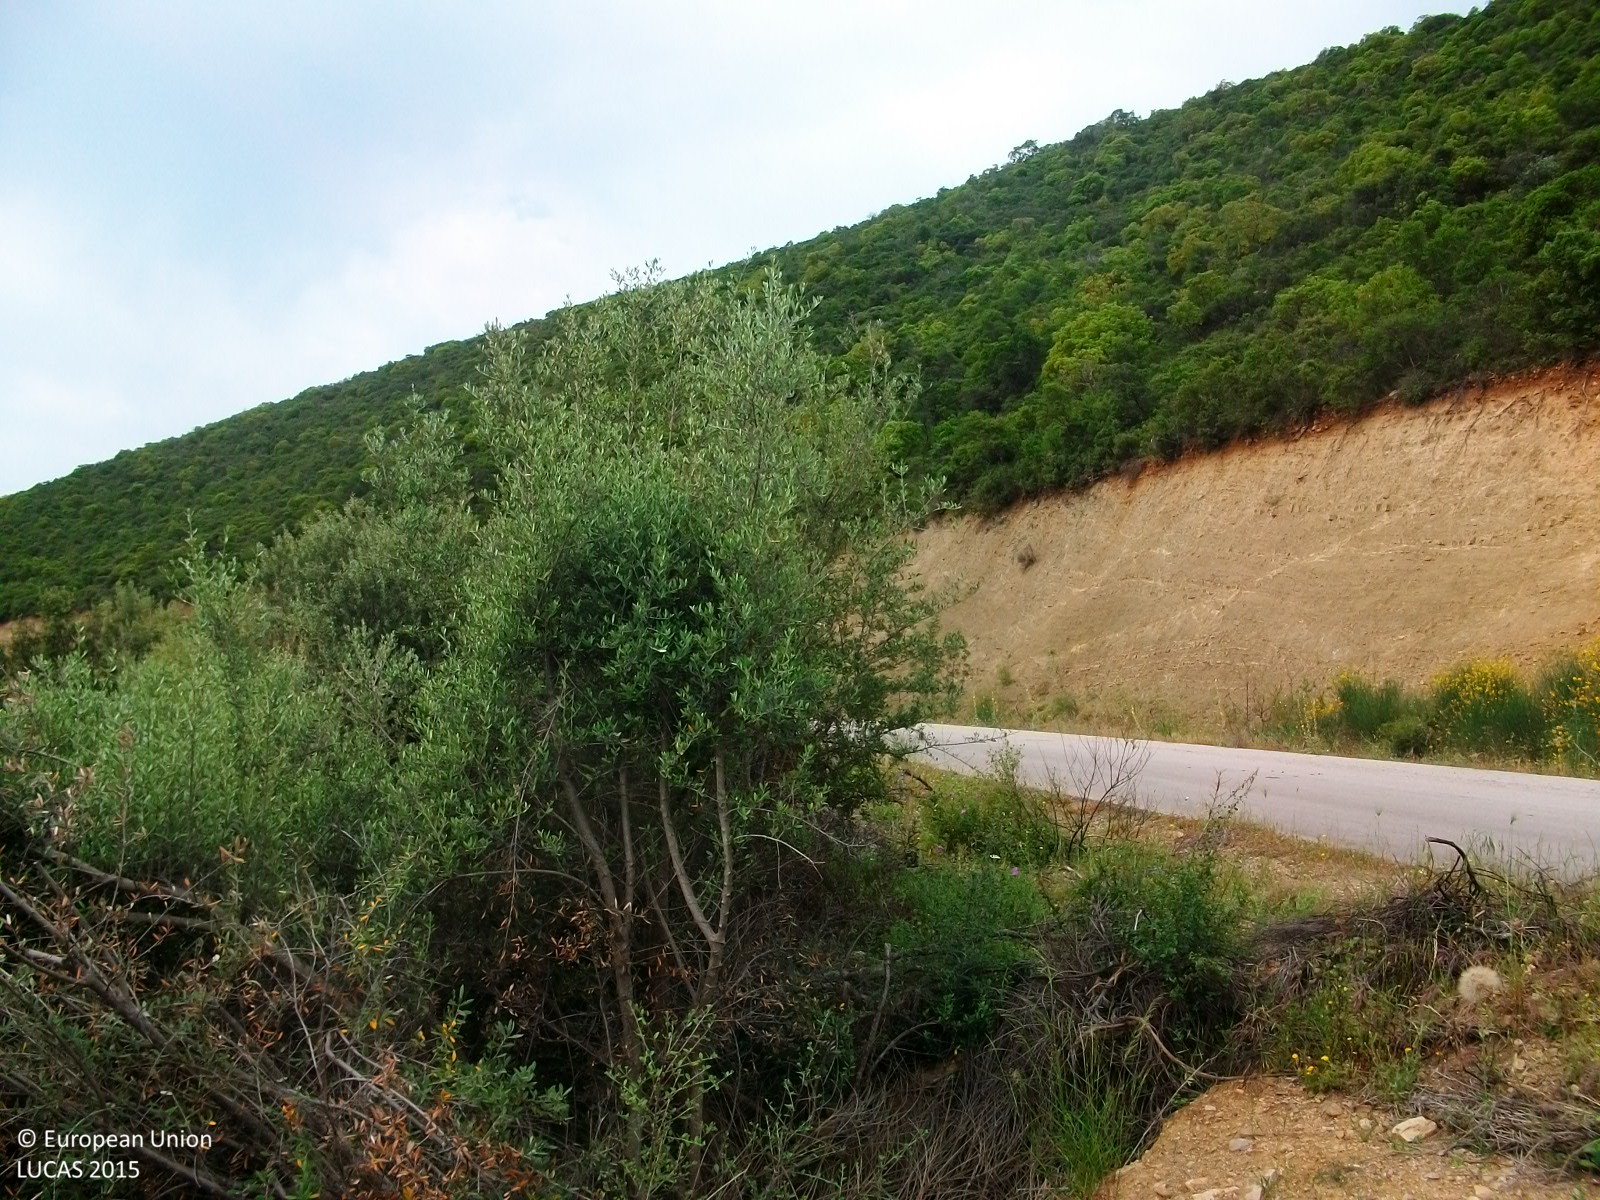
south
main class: Shrubland
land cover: Shrubland with sparse tree cover
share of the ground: > 75 %
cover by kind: shrubs 95 %, broadleaved forest trees 5 %
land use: Semi-natural and natural areas not in use
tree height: < 5 m
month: May
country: GR
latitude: 38.9402
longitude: 22.5925
